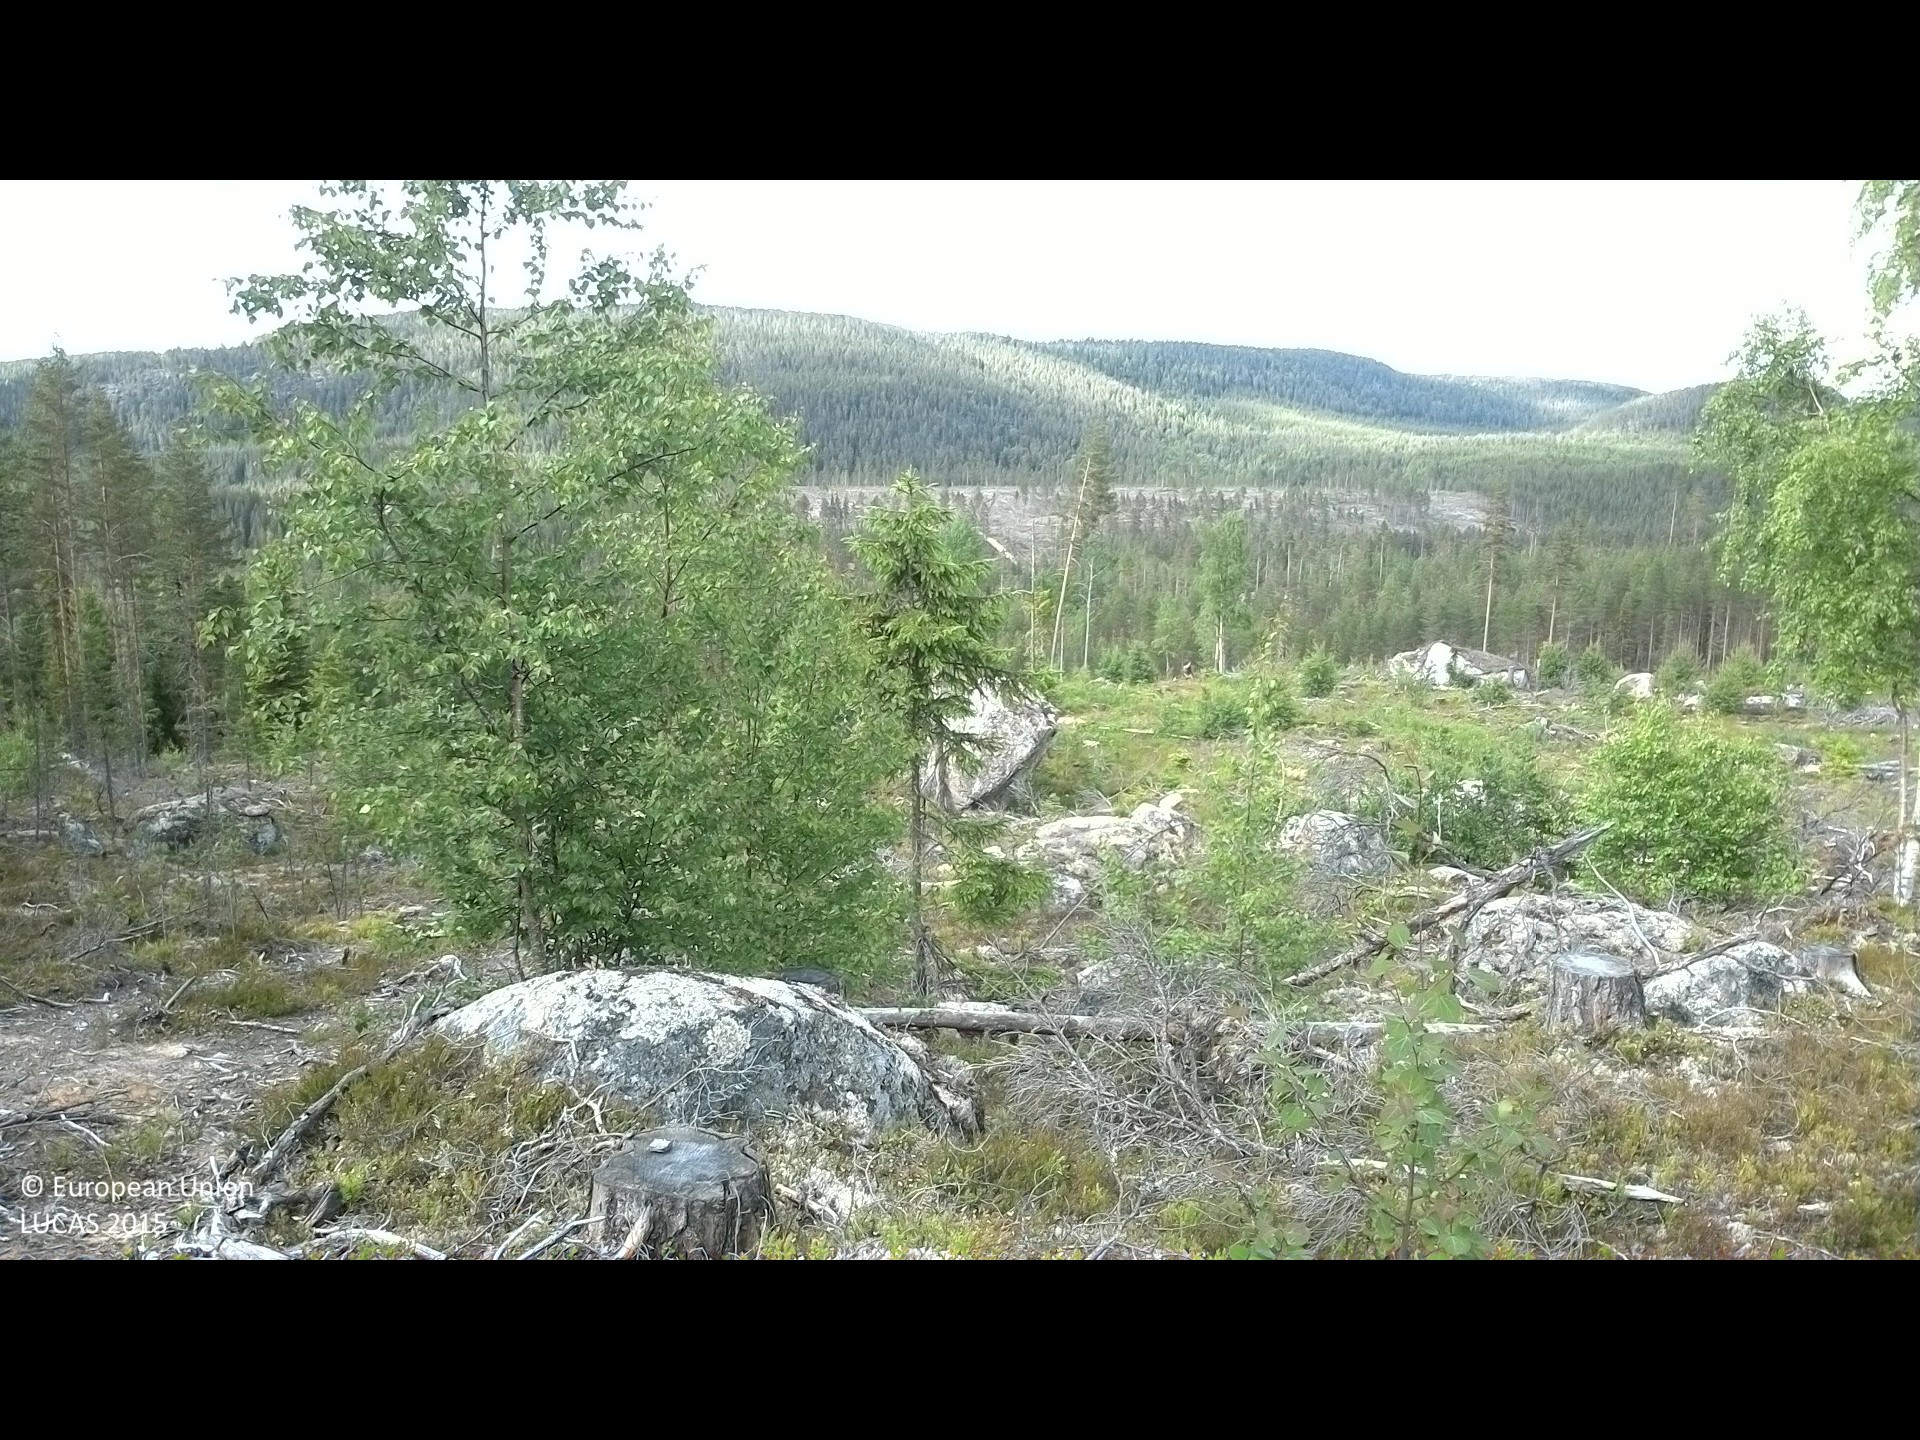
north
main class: Woodland
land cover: Broadleaved woodland
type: boreal forest
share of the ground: 10 - 25 %
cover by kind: shrubs 70 %, lichens and mosses 20 %, broadleaved forest trees 10 %
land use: Forestry
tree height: < 5 m
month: June
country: SE
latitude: 61.9641
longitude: 16.1037
